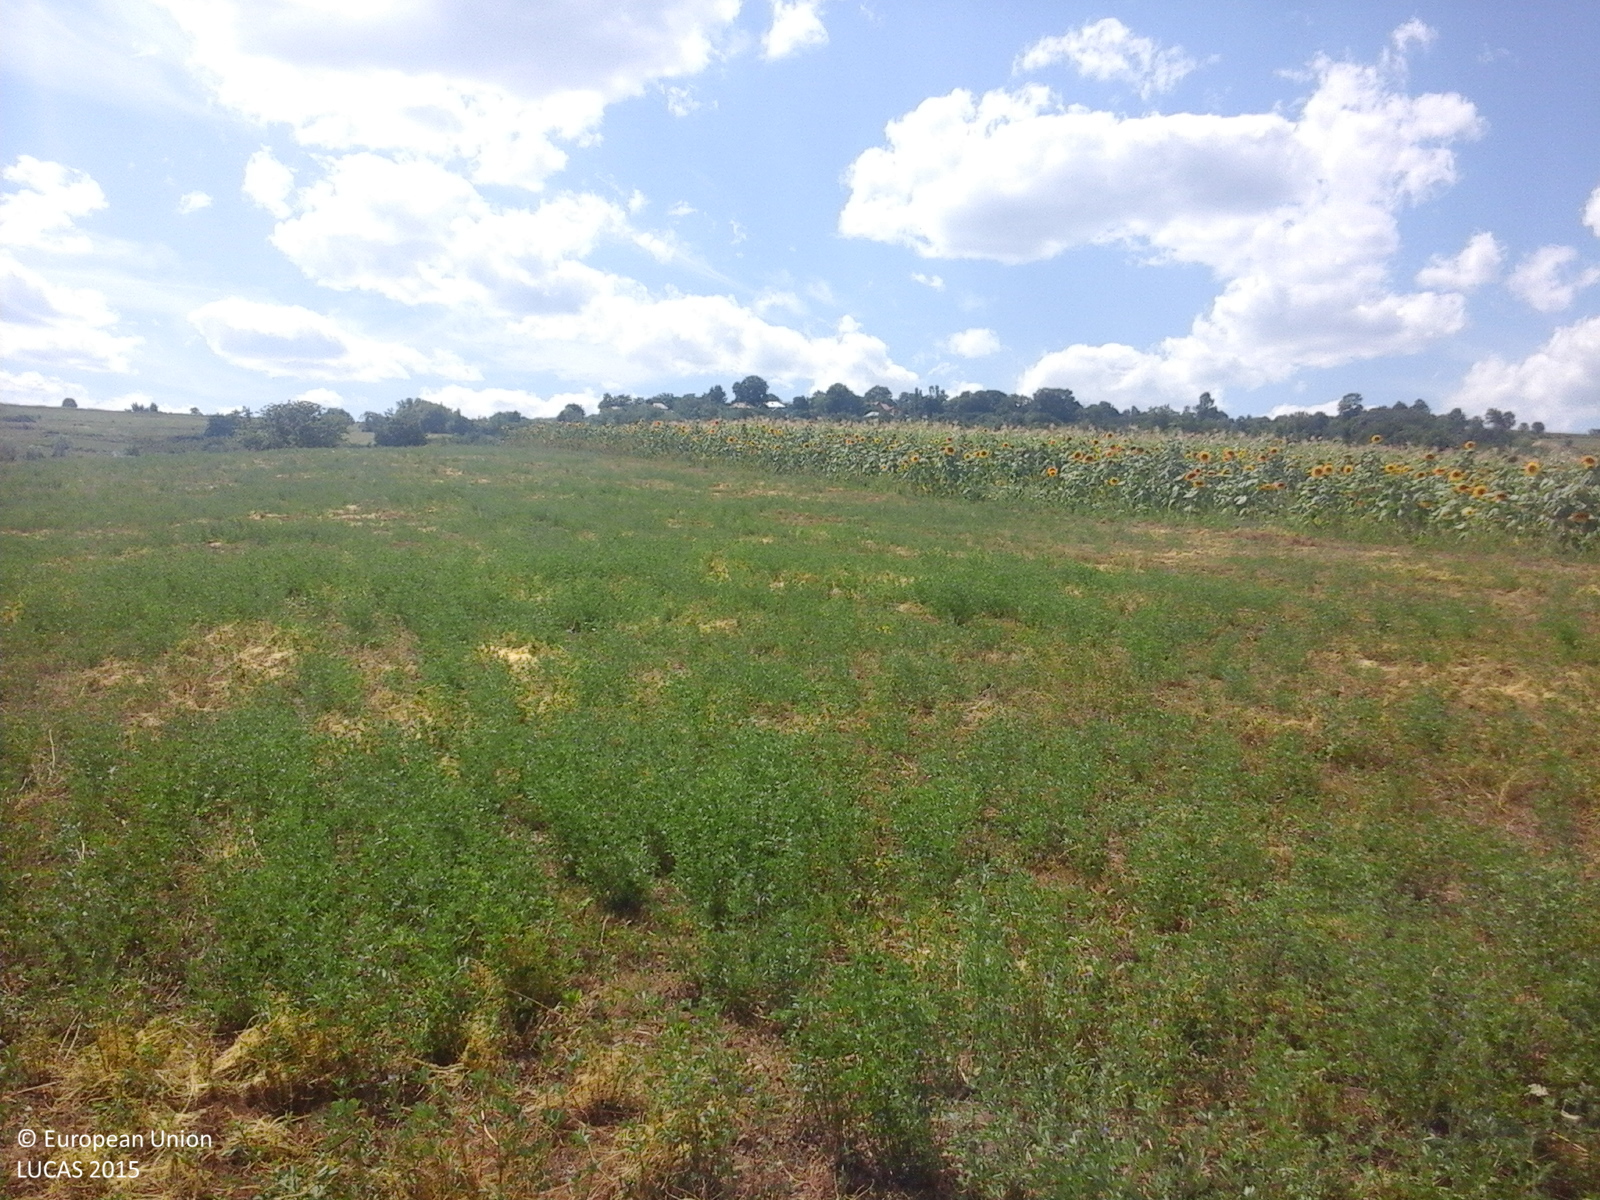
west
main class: Cropland
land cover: Lucerne
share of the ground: > 75 %
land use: Agriculture (excluding fallow land and kitchen gardens)
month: July
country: RO
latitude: 46.5727
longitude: 27.3694
